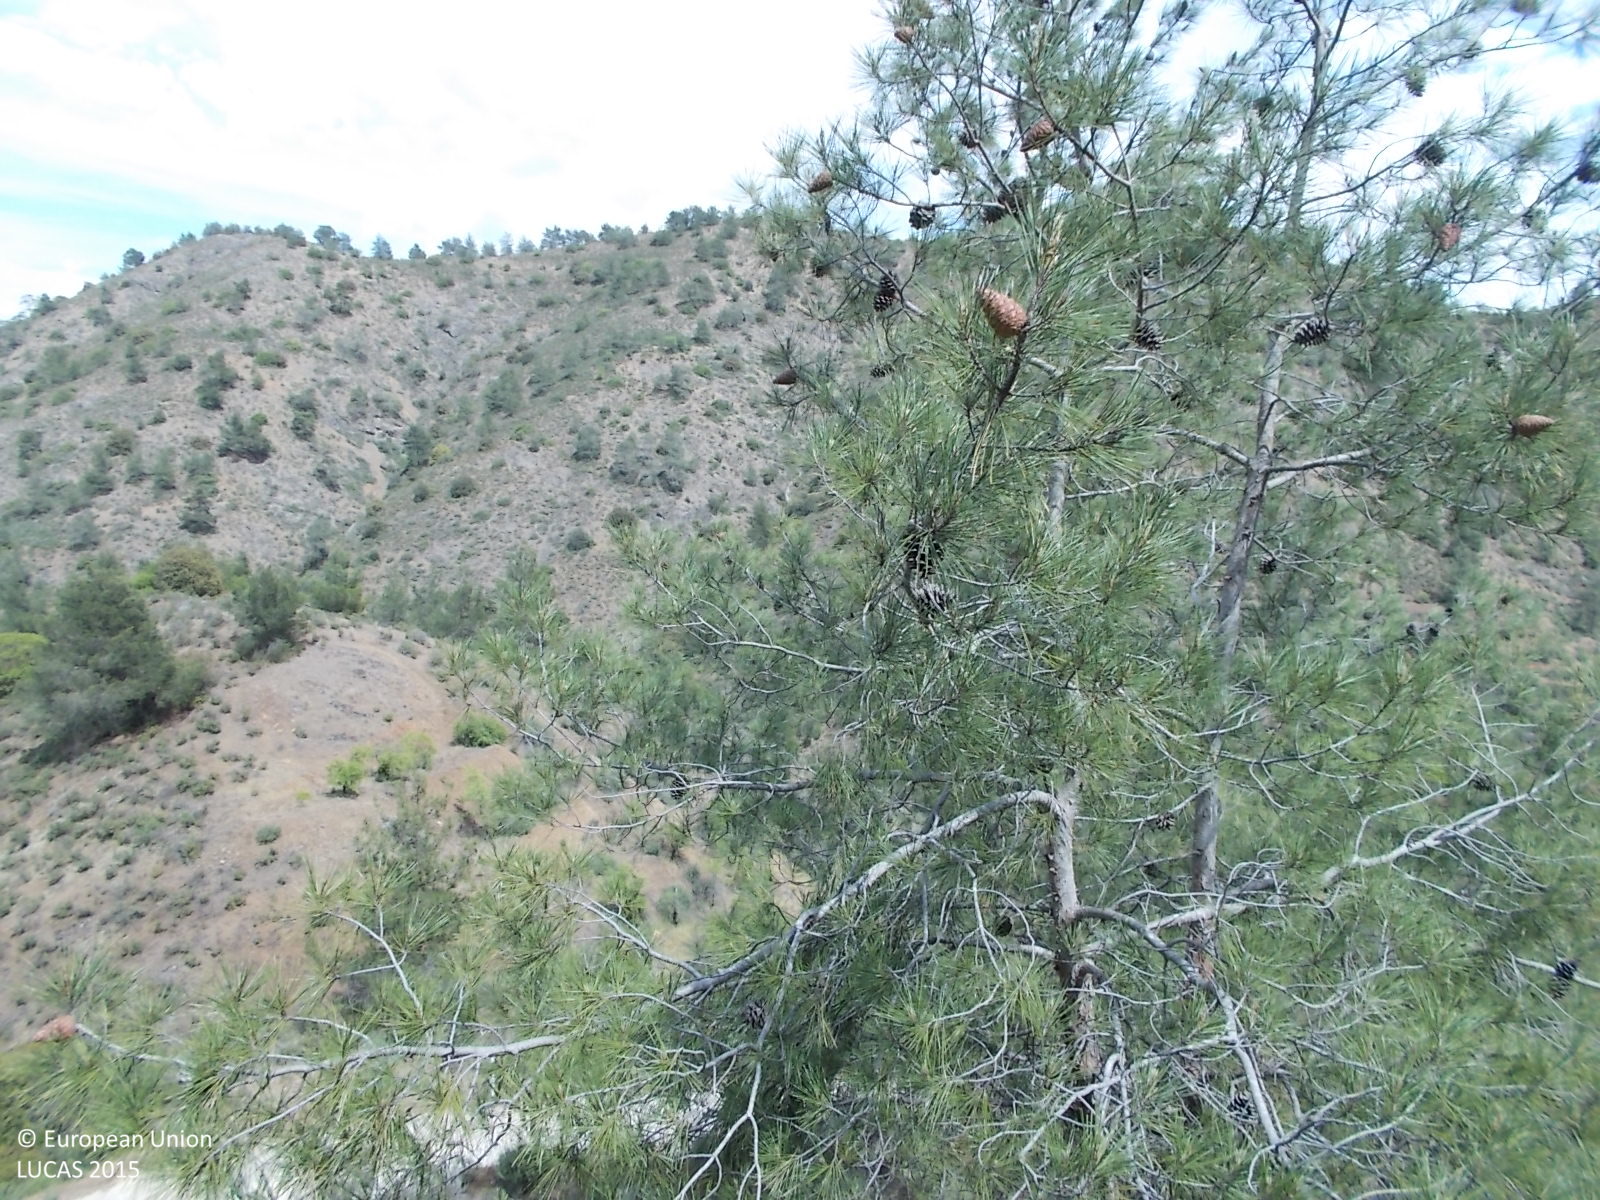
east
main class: Woodland
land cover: Pine dominated coniferous woodland
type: coniferous forest of the mediterranean region
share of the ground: > 75 %
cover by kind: coniferous forest trees 100 %
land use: Forestry
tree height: > 5 m
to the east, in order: Pine dominated coniferous woodland; Other bare soil; Pine dominated coniferous woodland; Paved roads, cycling and walking lanes; Nuts trees; Pine dominated coniferous woodland; Shrubland with sparse tree cover; Rivers and streams; Rocks and stones; Pine dominated coniferous woodland; Tracks; Shrubland with sparse tree cover
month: May
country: CY
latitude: 34.9622
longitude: 33.0756
